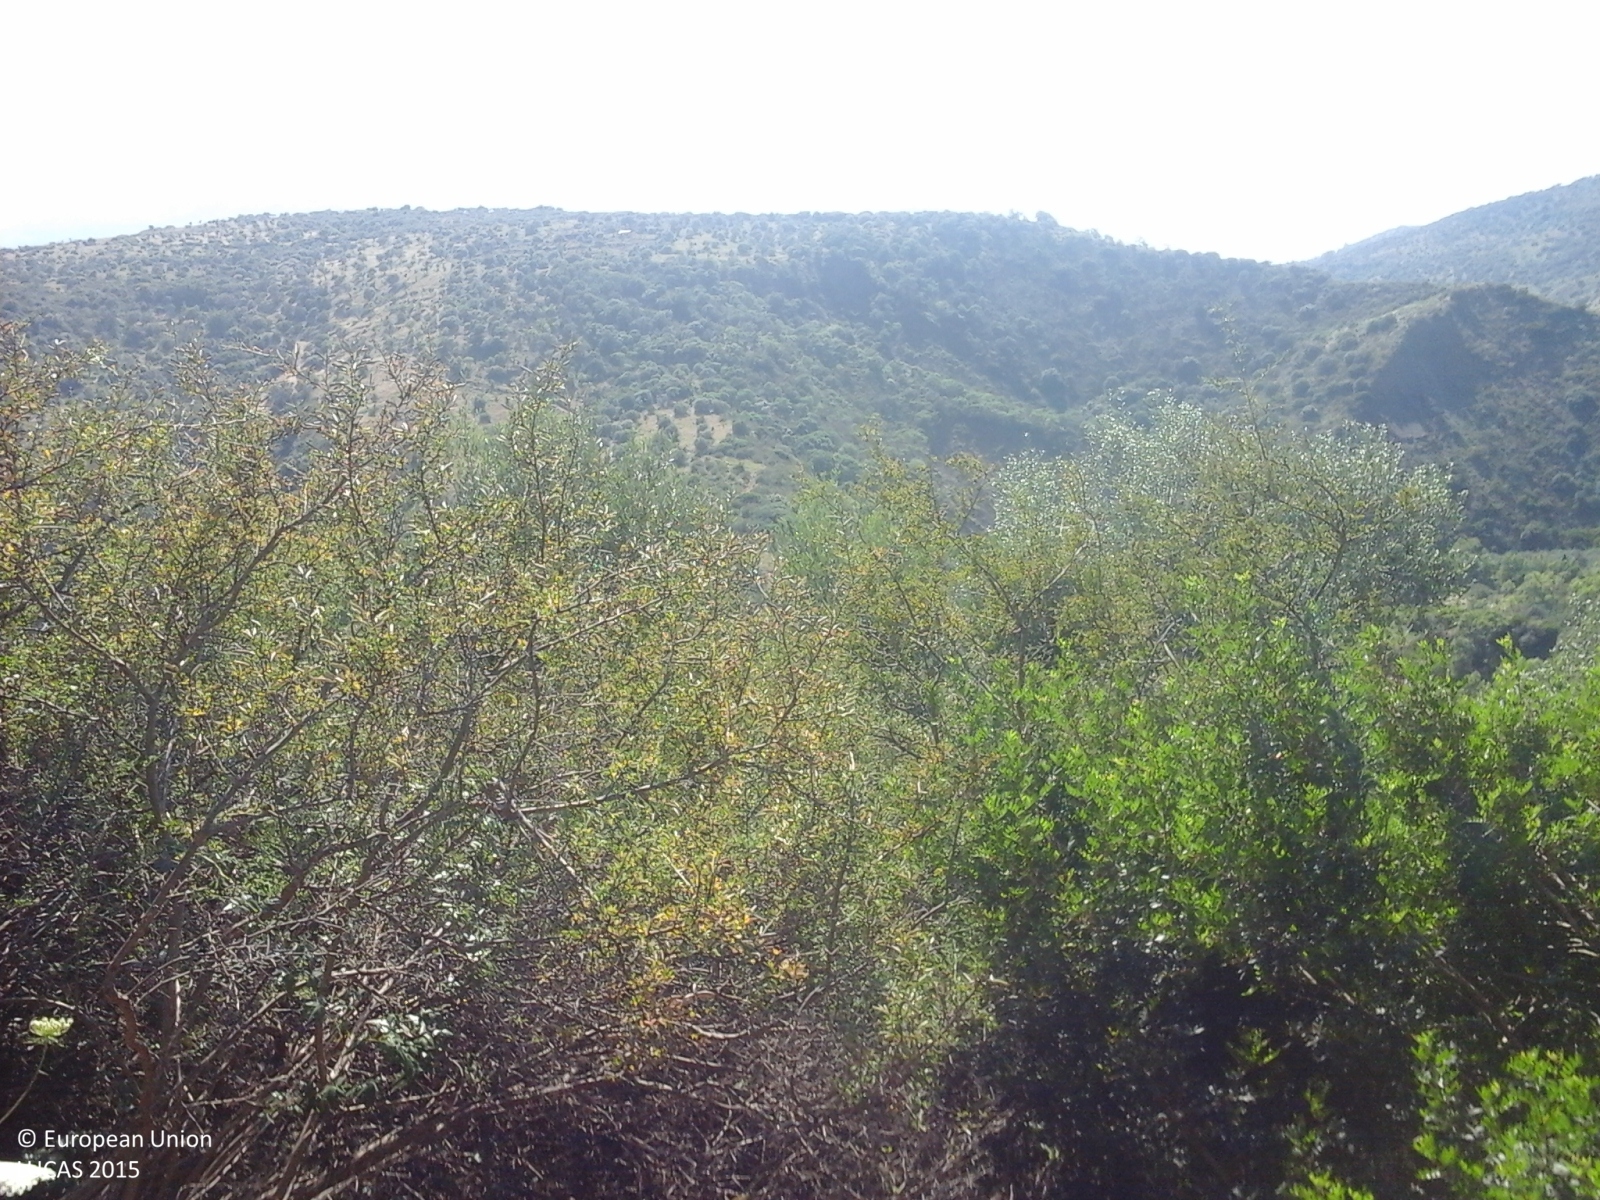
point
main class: Woodland
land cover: Broadleaved woodland
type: broadleaved evergreen forest
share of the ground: > 75 %
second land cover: Grassland without tree/shrub cover
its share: > 75 %
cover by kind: broadleaved forest trees 45 %, shrubs 40 %, herbaceous plants 15 %
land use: Forestry
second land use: Agriculture (excluding fallow land and kitchen gardens)
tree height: > 5 m
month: June
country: IT
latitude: 37.9297
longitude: 14.1464
